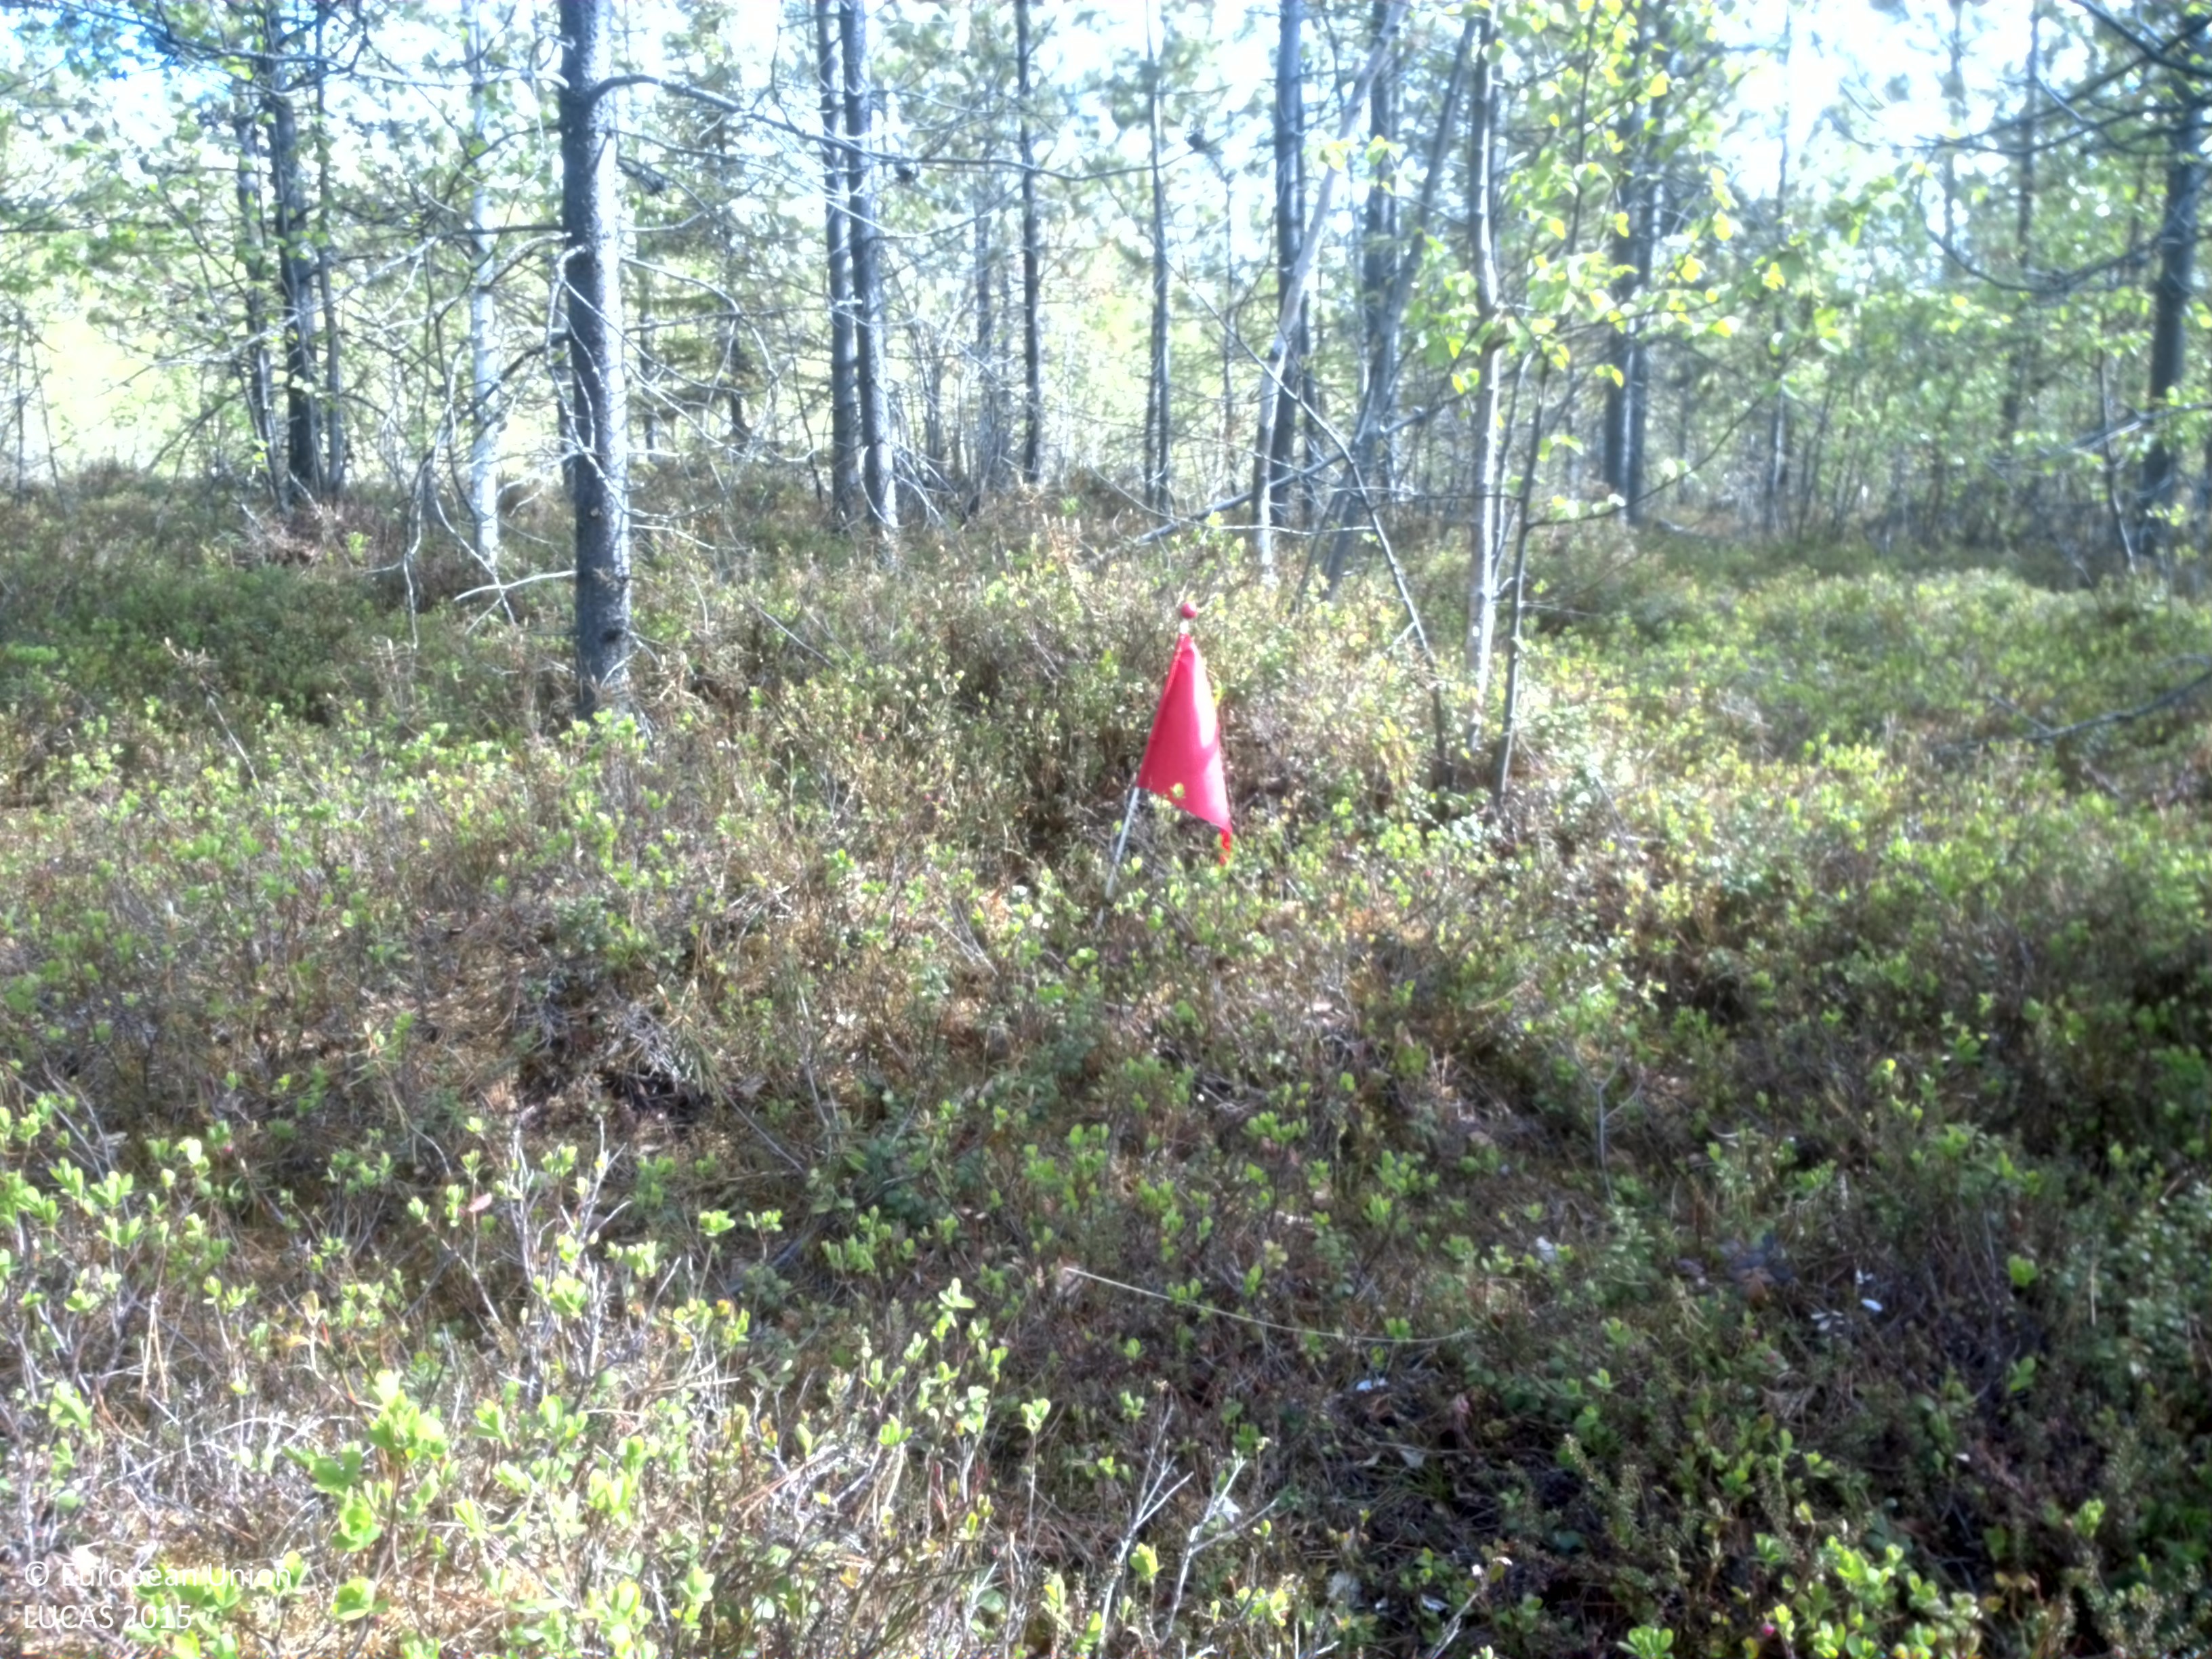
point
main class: Woodland
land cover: Pine dominated mixed woodland
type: boreal forest
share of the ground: 25 - 50 %
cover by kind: shrubs 60 %, coniferous forest trees 25 %, broadleaved forest trees 15 %
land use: Forestry
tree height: > 5 m
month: June
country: SE
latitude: 67.0041
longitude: 21.7253
